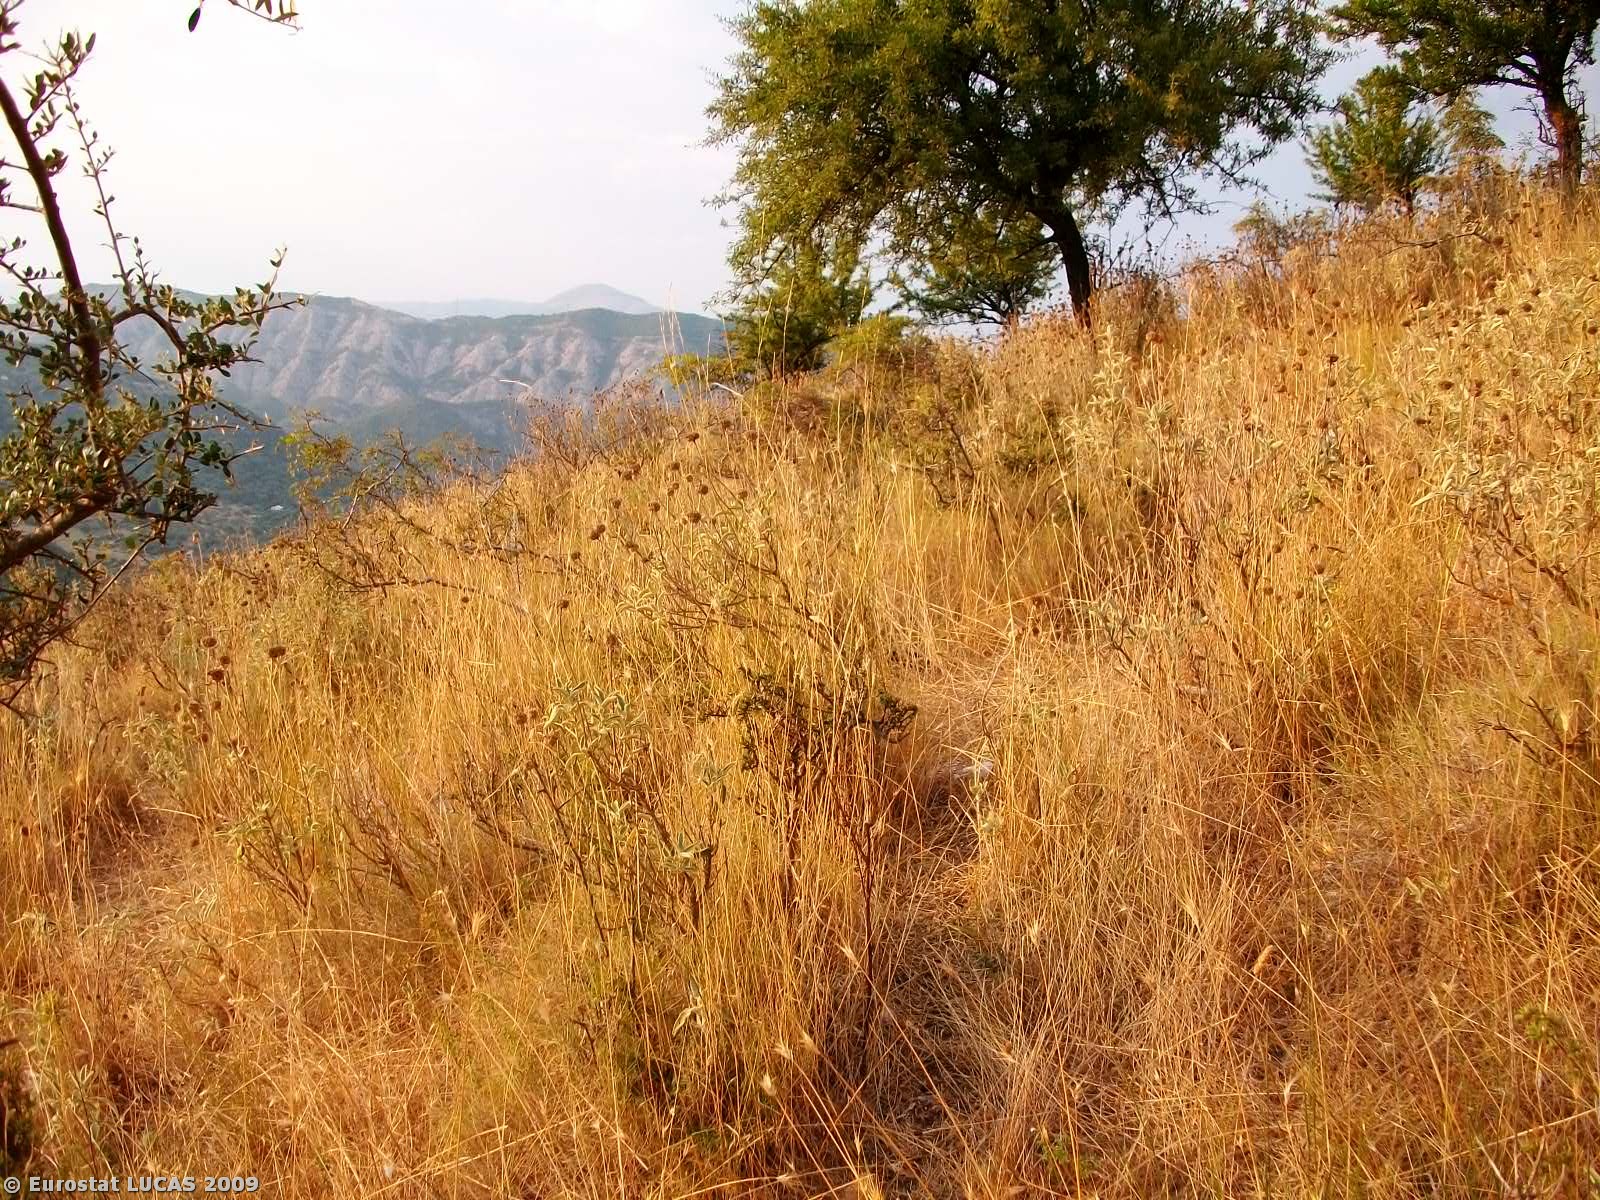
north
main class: Grassland
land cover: Grassland with sparse tree/shrub cover
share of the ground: > 75 %
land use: Unused
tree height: < 5 m
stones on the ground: > 50 %
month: August
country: GR
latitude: 39.5419
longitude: 20.2954
